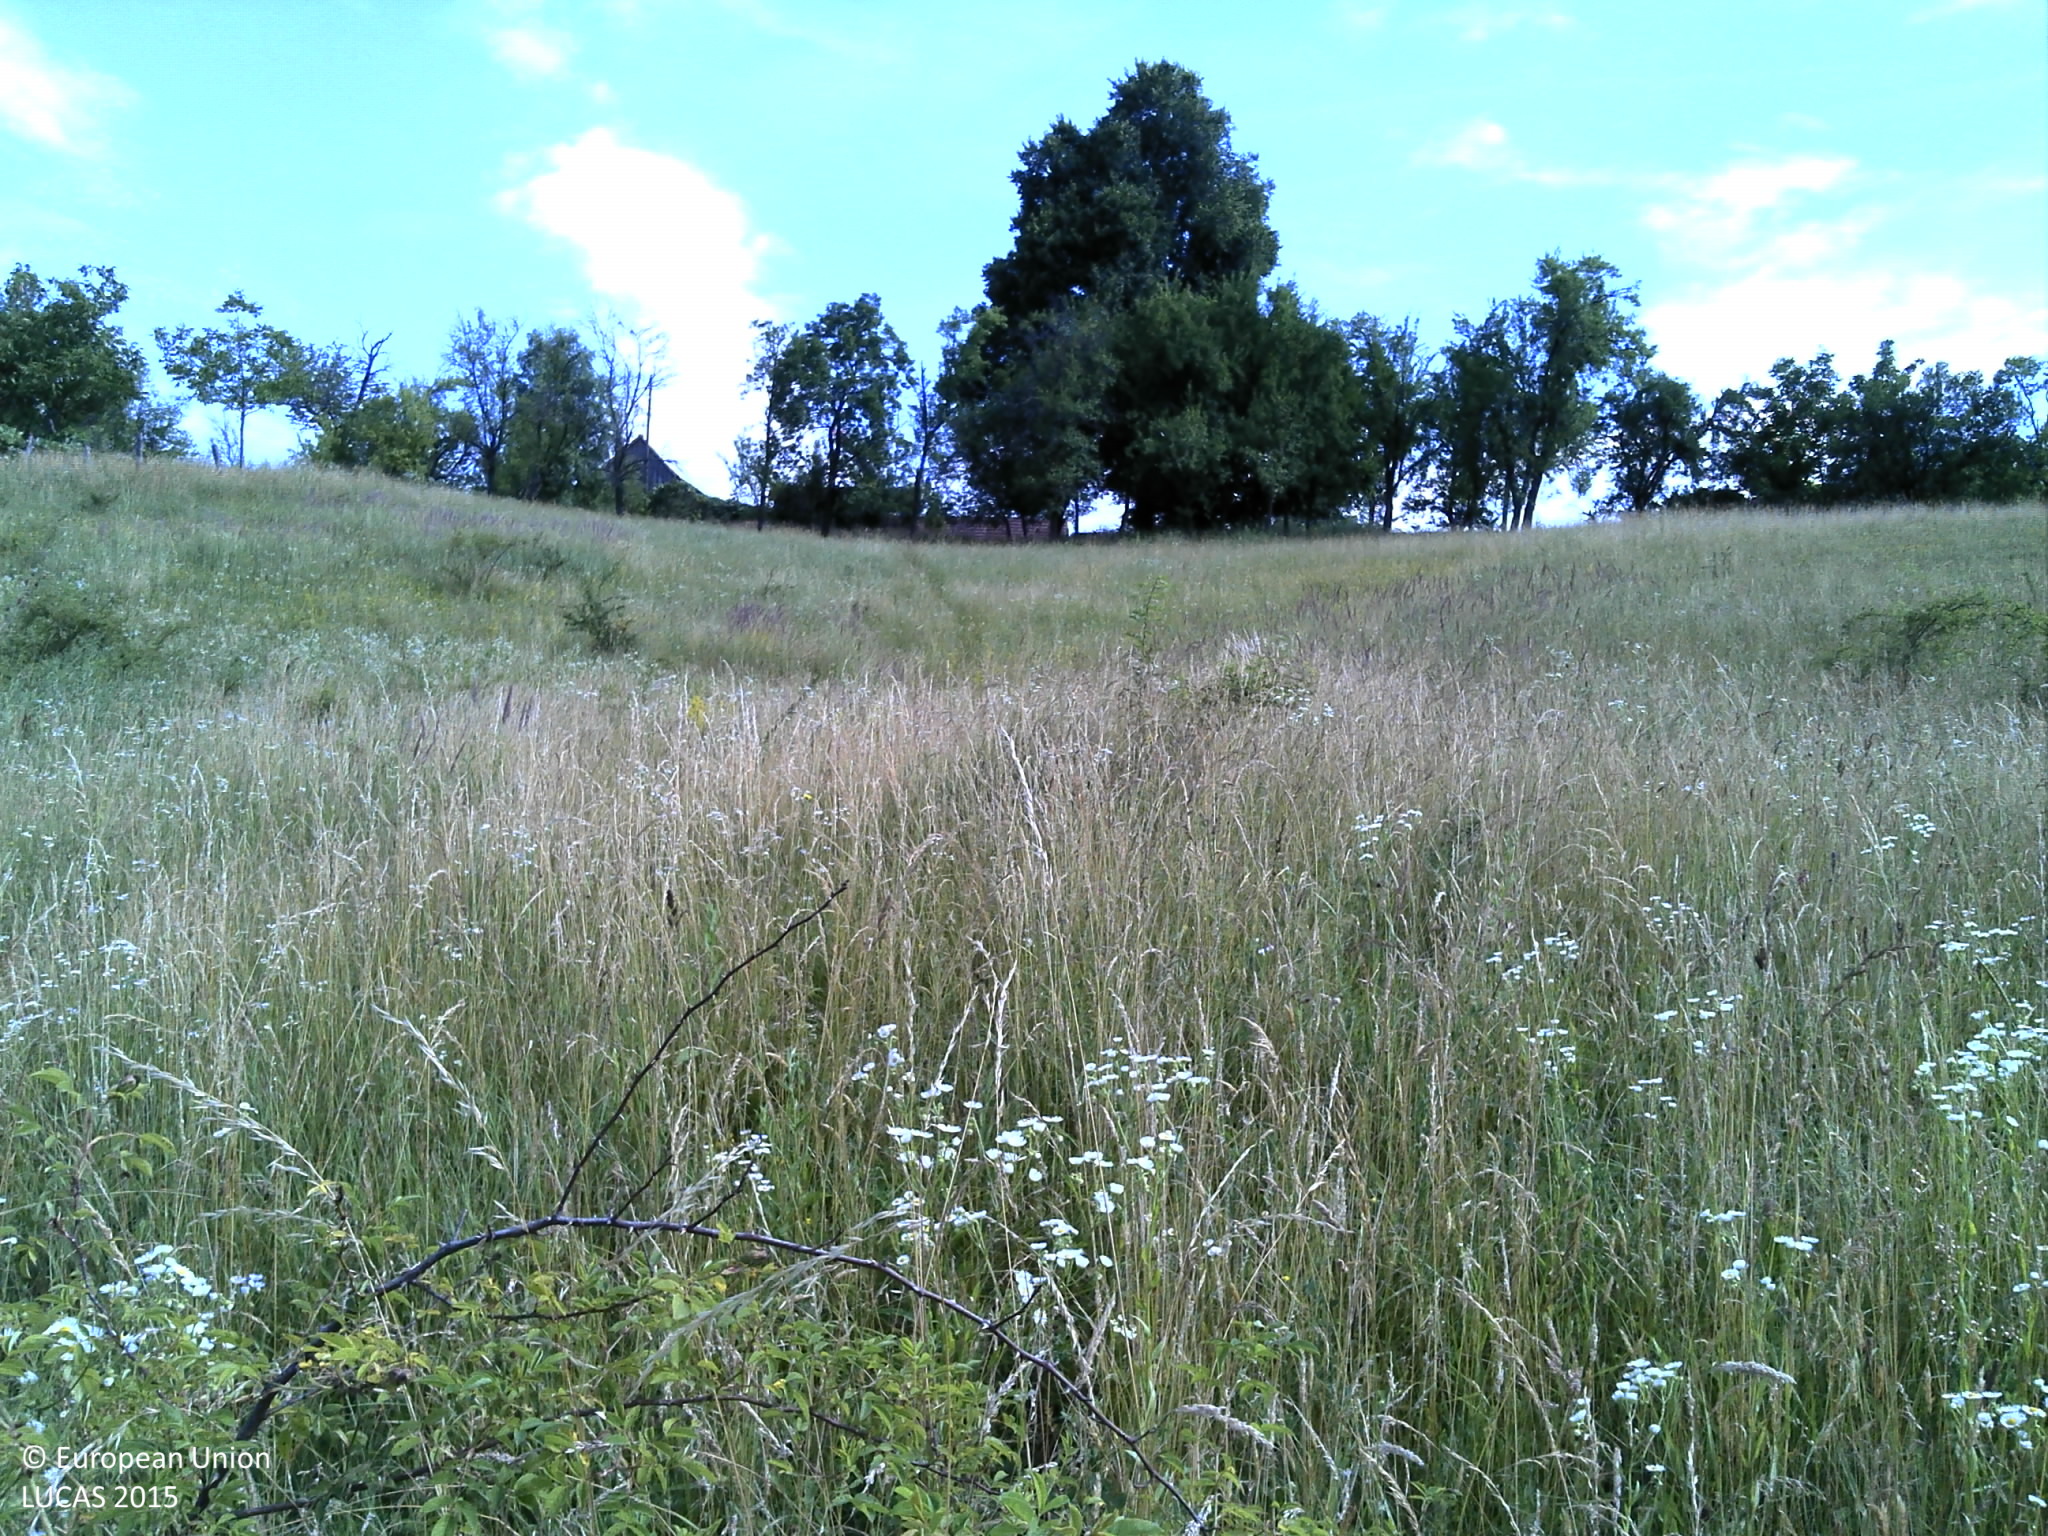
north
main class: Grassland
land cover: Spontaneously vegetated surfaces
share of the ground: > 75 %
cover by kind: herbaceous plants 100 %
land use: Fallow land
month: June
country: HR
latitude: 45.7067
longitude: 17.5165
